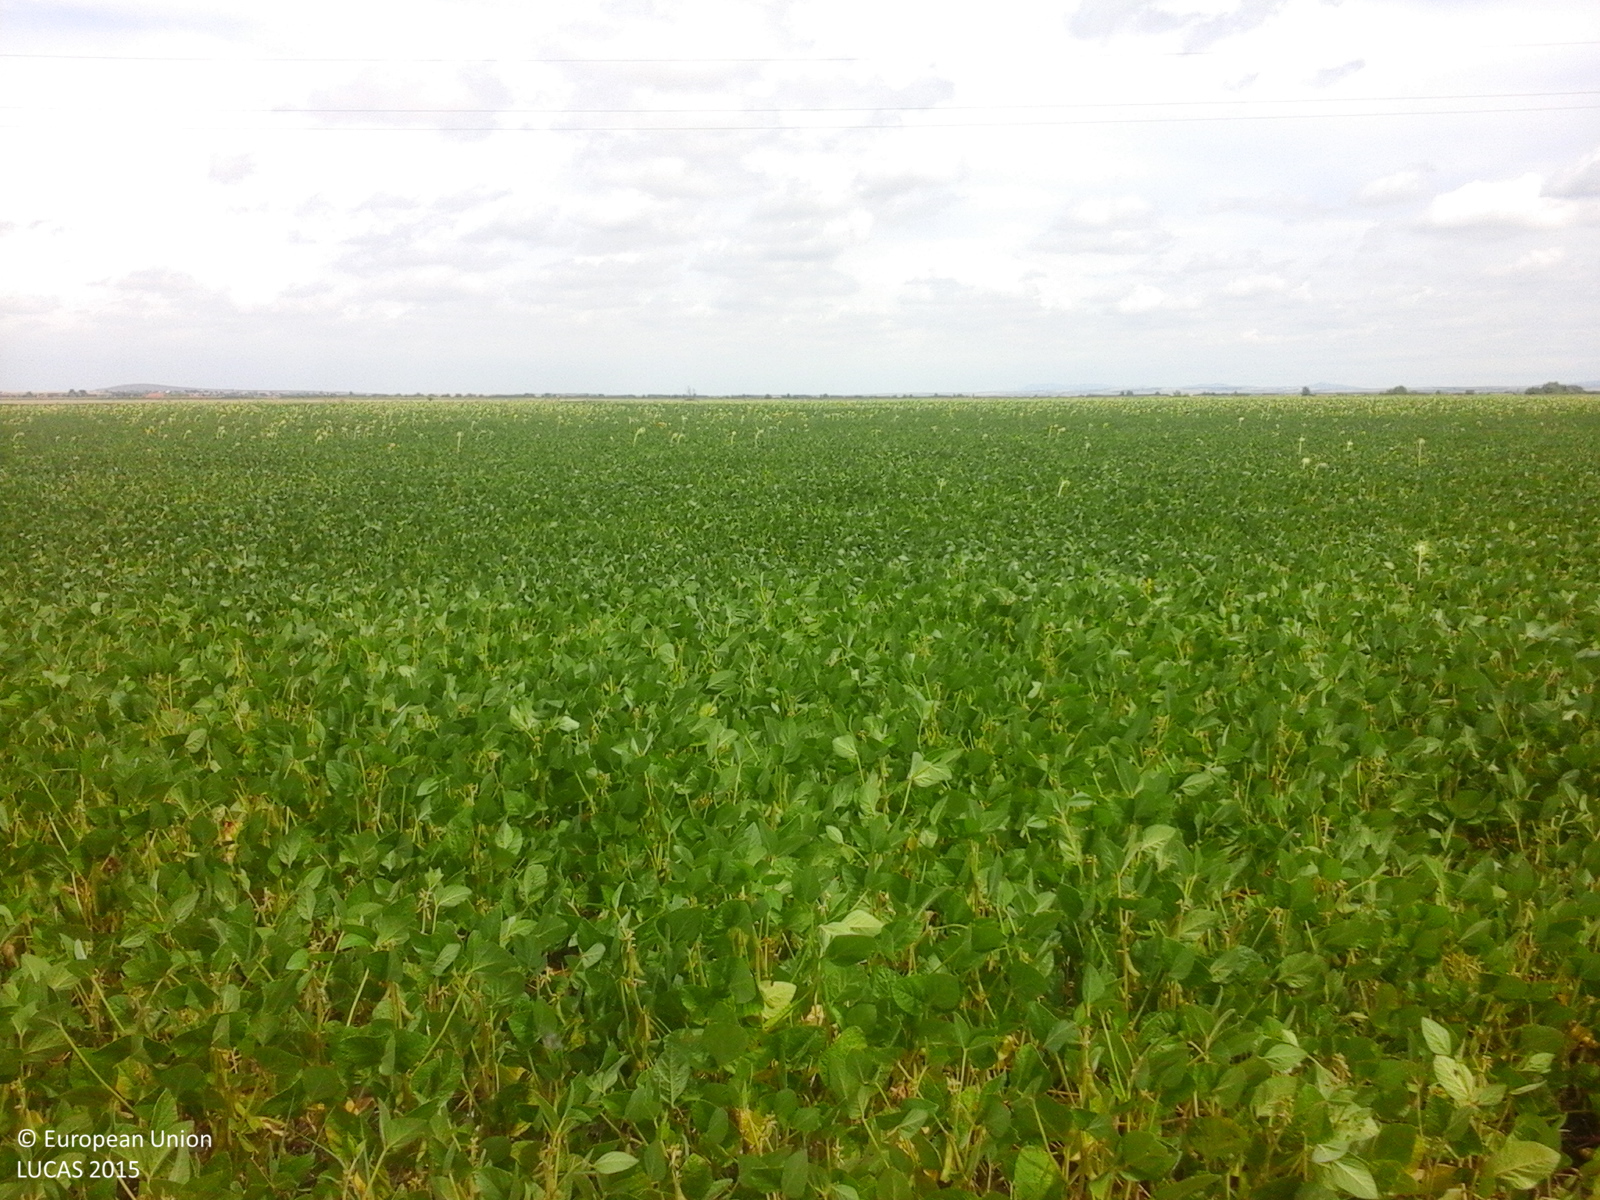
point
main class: Cropland
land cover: Soya
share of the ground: > 75 %
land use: Agriculture (excluding fallow land and kitchen gardens)
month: August
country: RO
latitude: 45.2916
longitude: 21.3390
